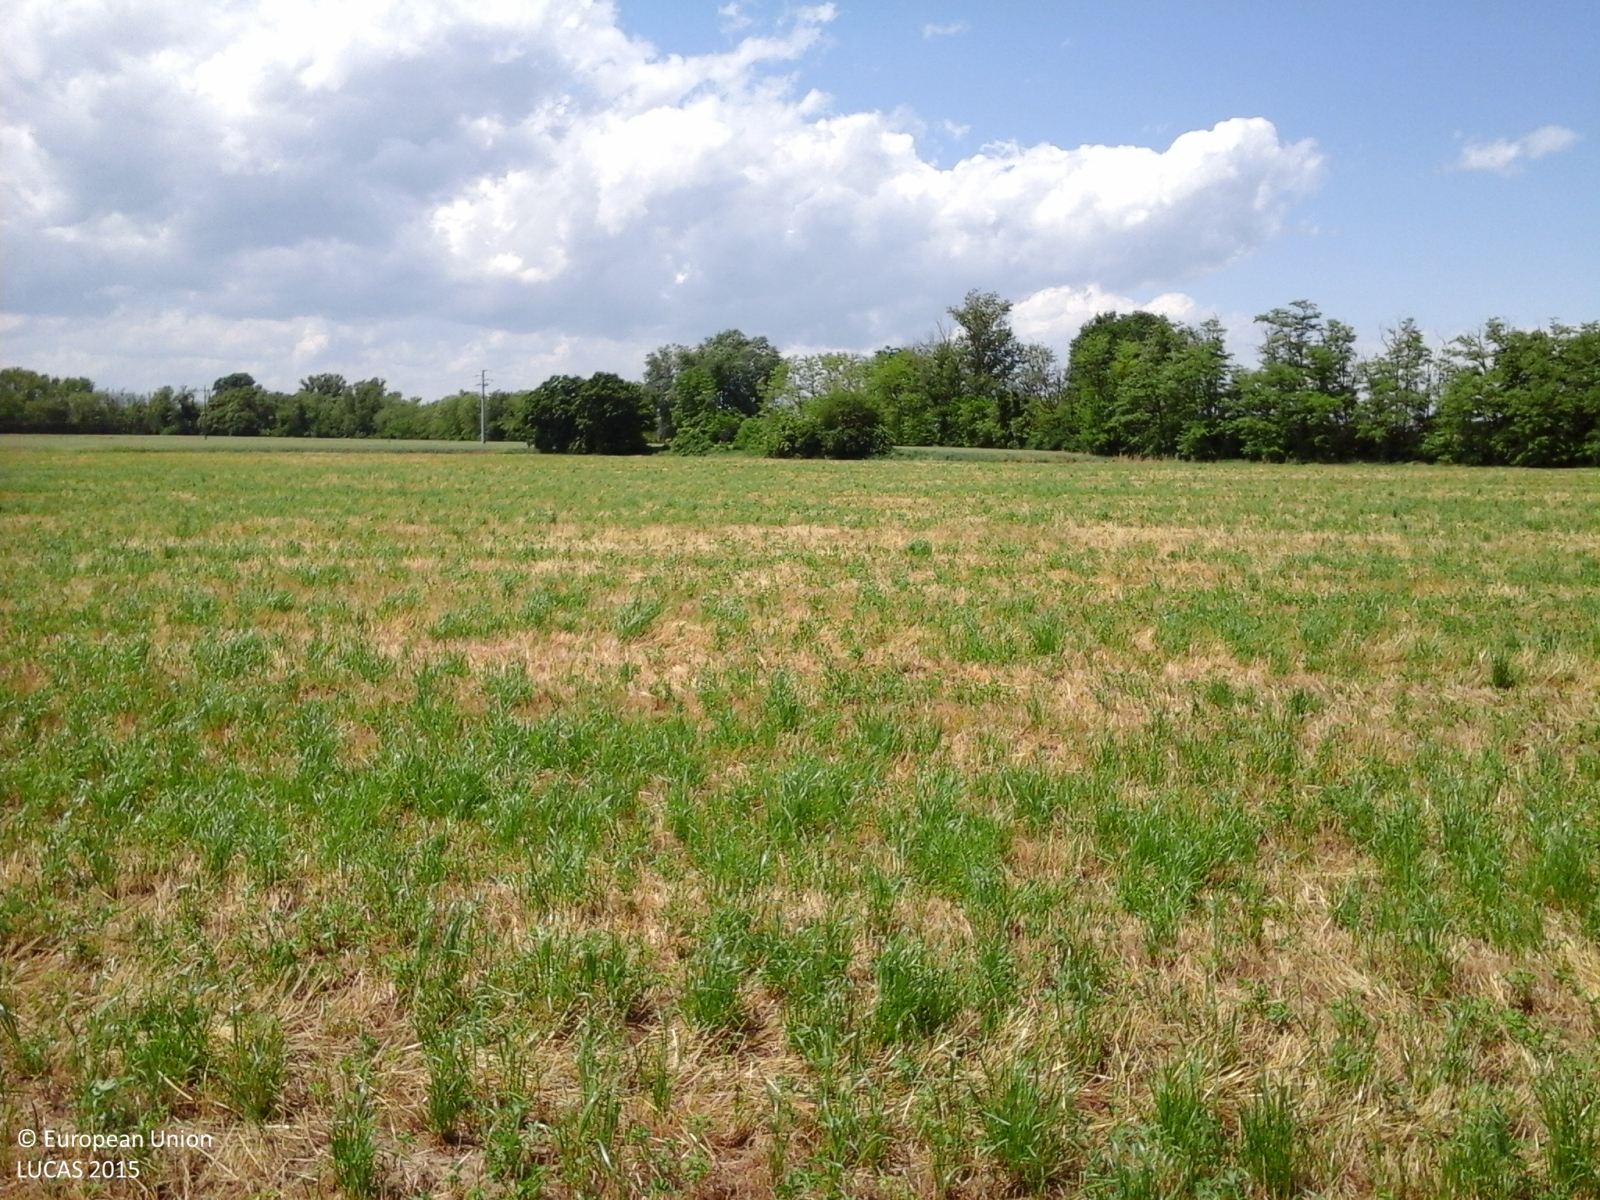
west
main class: Cropland
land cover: Lucerne
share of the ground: > 75 %
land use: Agriculture (excluding fallow land and kitchen gardens)
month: May
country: IT
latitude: 44.6552
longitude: 10.6418
